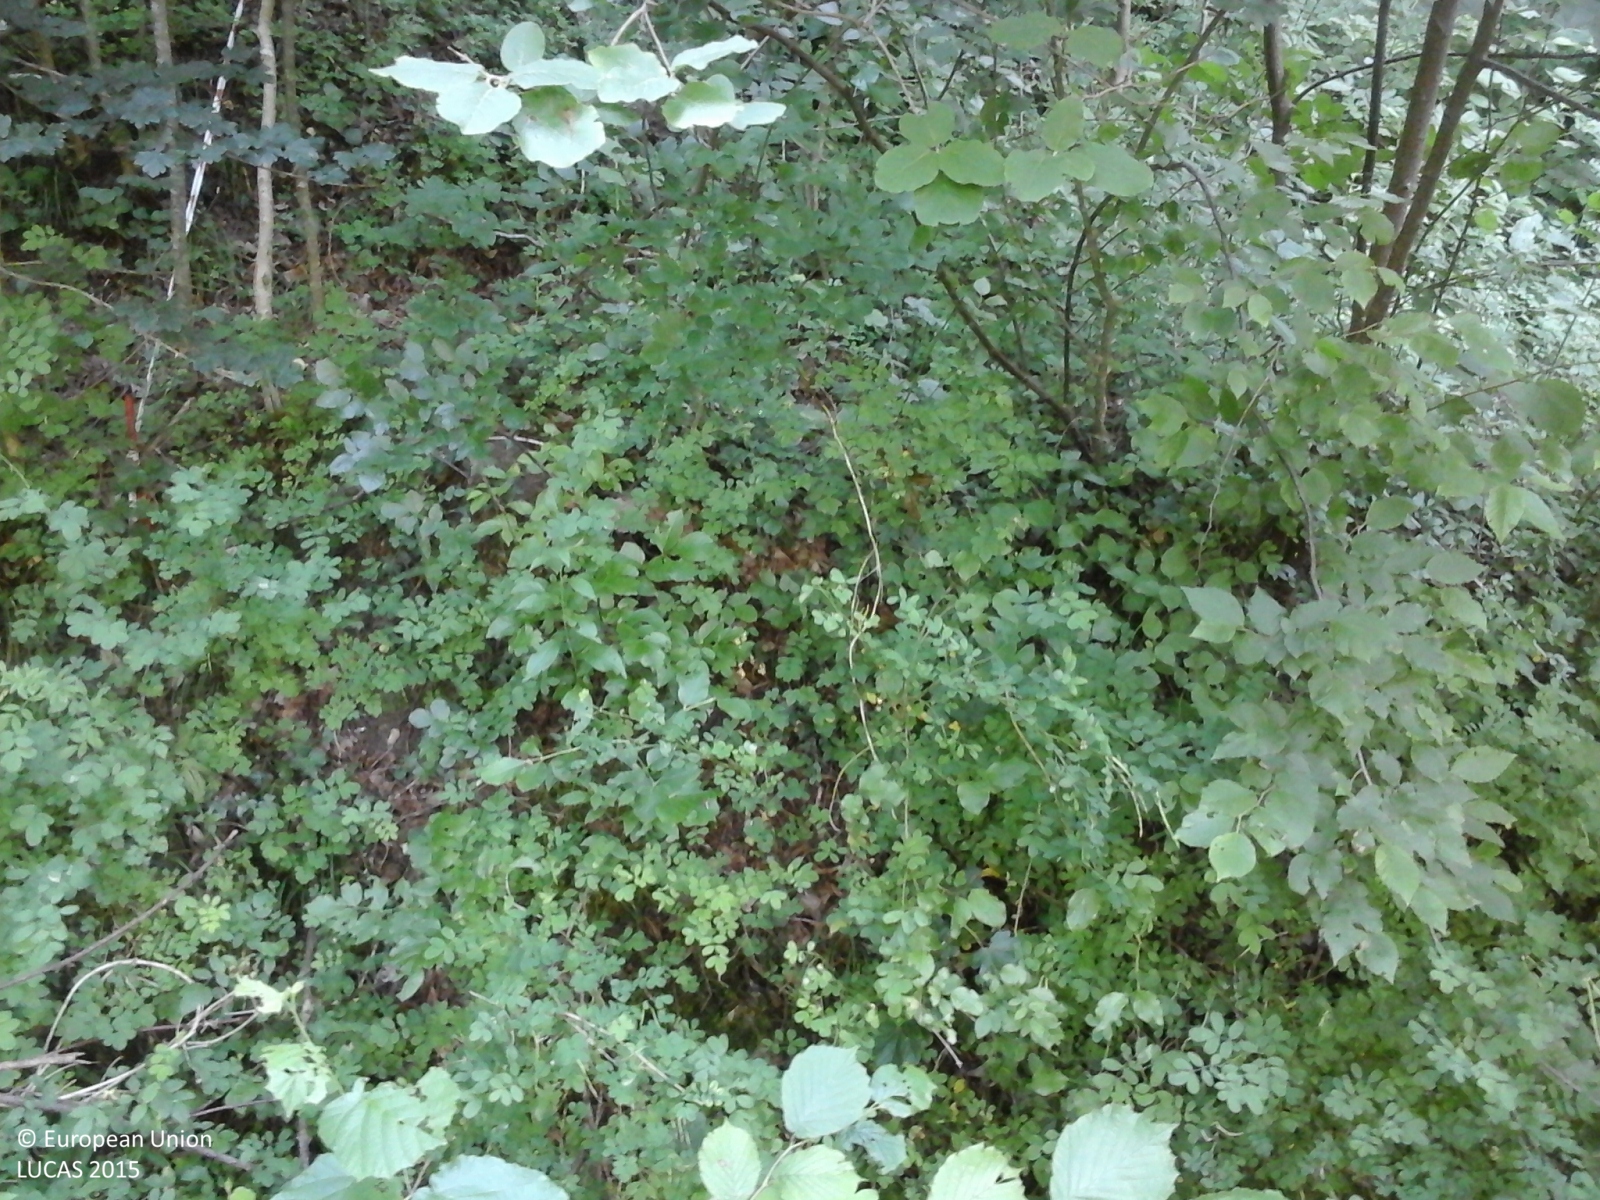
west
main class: Woodland
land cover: Broadleaved woodland
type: thermophilous deciduous forest
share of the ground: > 75 %
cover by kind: broadleaved forest trees 100 %
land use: Forestry
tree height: > 5 m
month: July
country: IT
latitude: 45.5518
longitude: 11.1893
